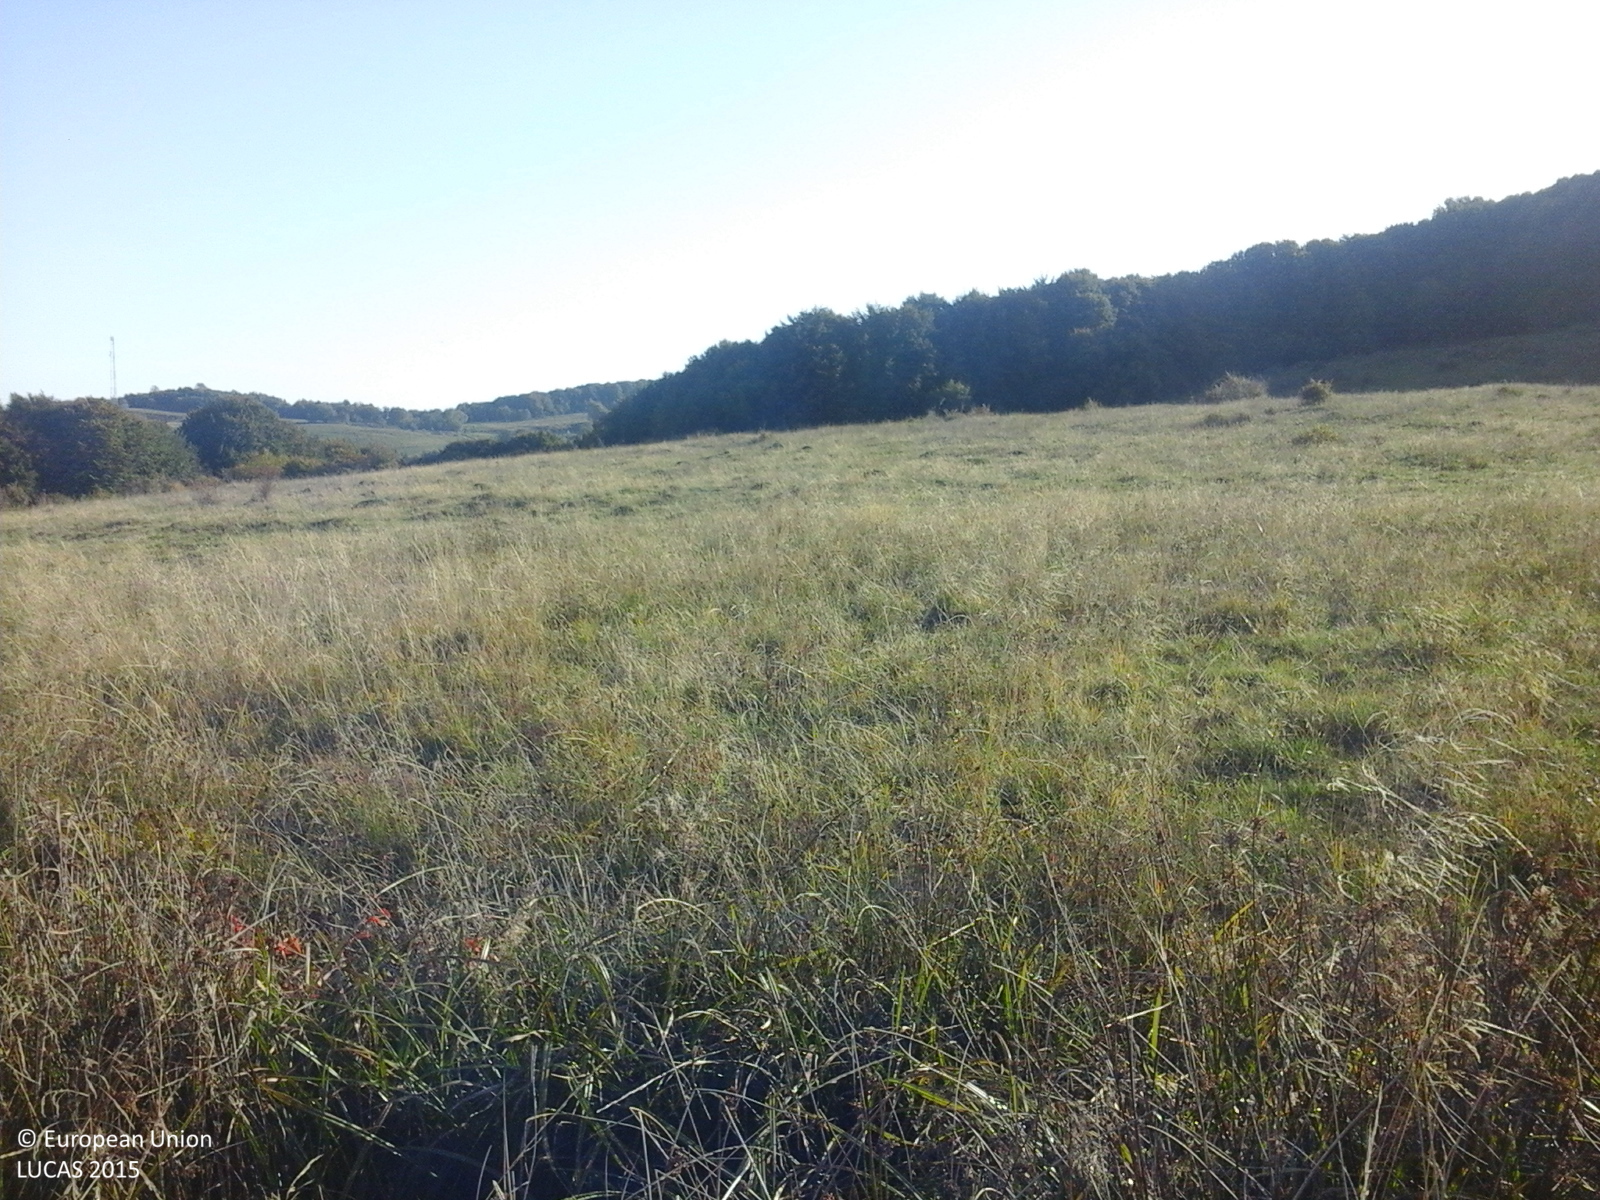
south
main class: Grassland
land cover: Grassland without tree/shrub cover
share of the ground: > 75 %
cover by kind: herbaceous plants 100 %
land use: Agriculture (excluding fallow land and kitchen gardens)
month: October
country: RO
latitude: 46.4526
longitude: 25.1637
